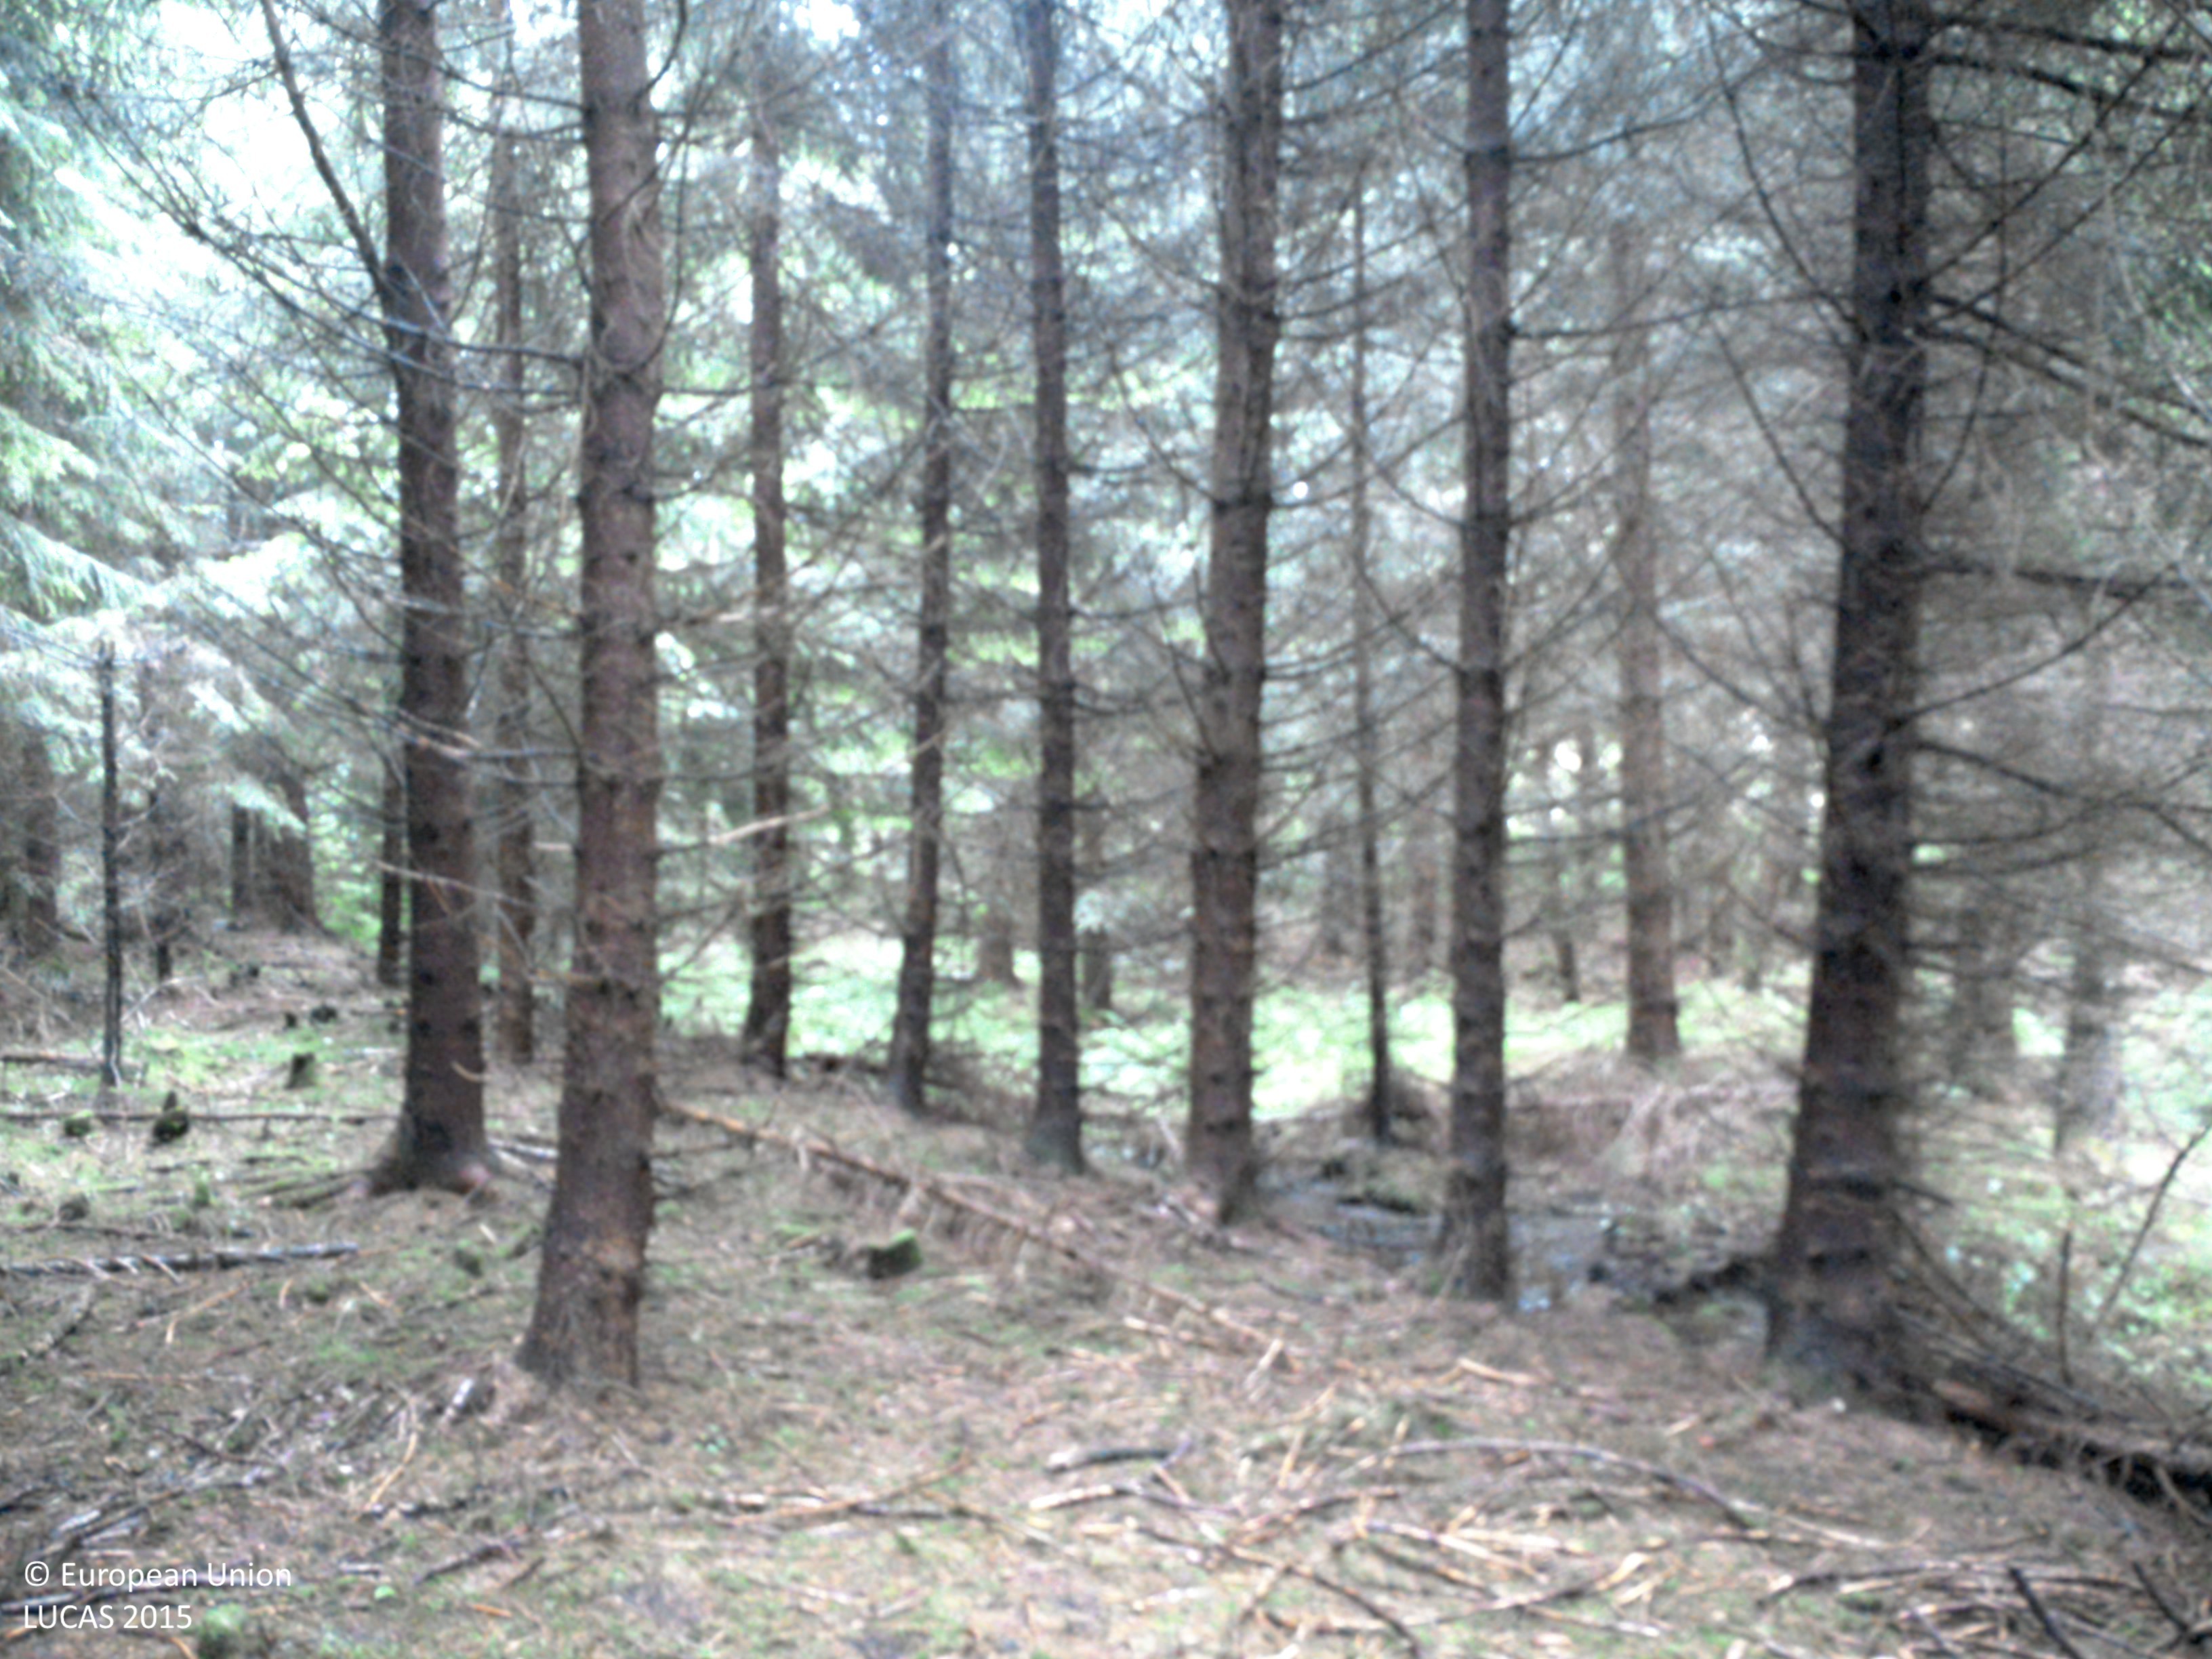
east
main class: Woodland
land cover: Spruce dominated coniferous woodland
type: boreal forest
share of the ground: > 75 %
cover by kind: coniferous forest trees 80 %, lichens and mosses 20 %
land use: Forestry
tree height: > 5 m
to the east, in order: Spruce dominated coniferous woodland; Spruce dominated mixed woodland; Ditches and canals; Spruce dominated coniferous woodland; Spruce dominated mixed woodland; Spruce dominated coniferous woodland; Ditches and canals; Spruce dominated coniferous woodland
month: July
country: SE
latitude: 58.6902
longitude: 12.0142
